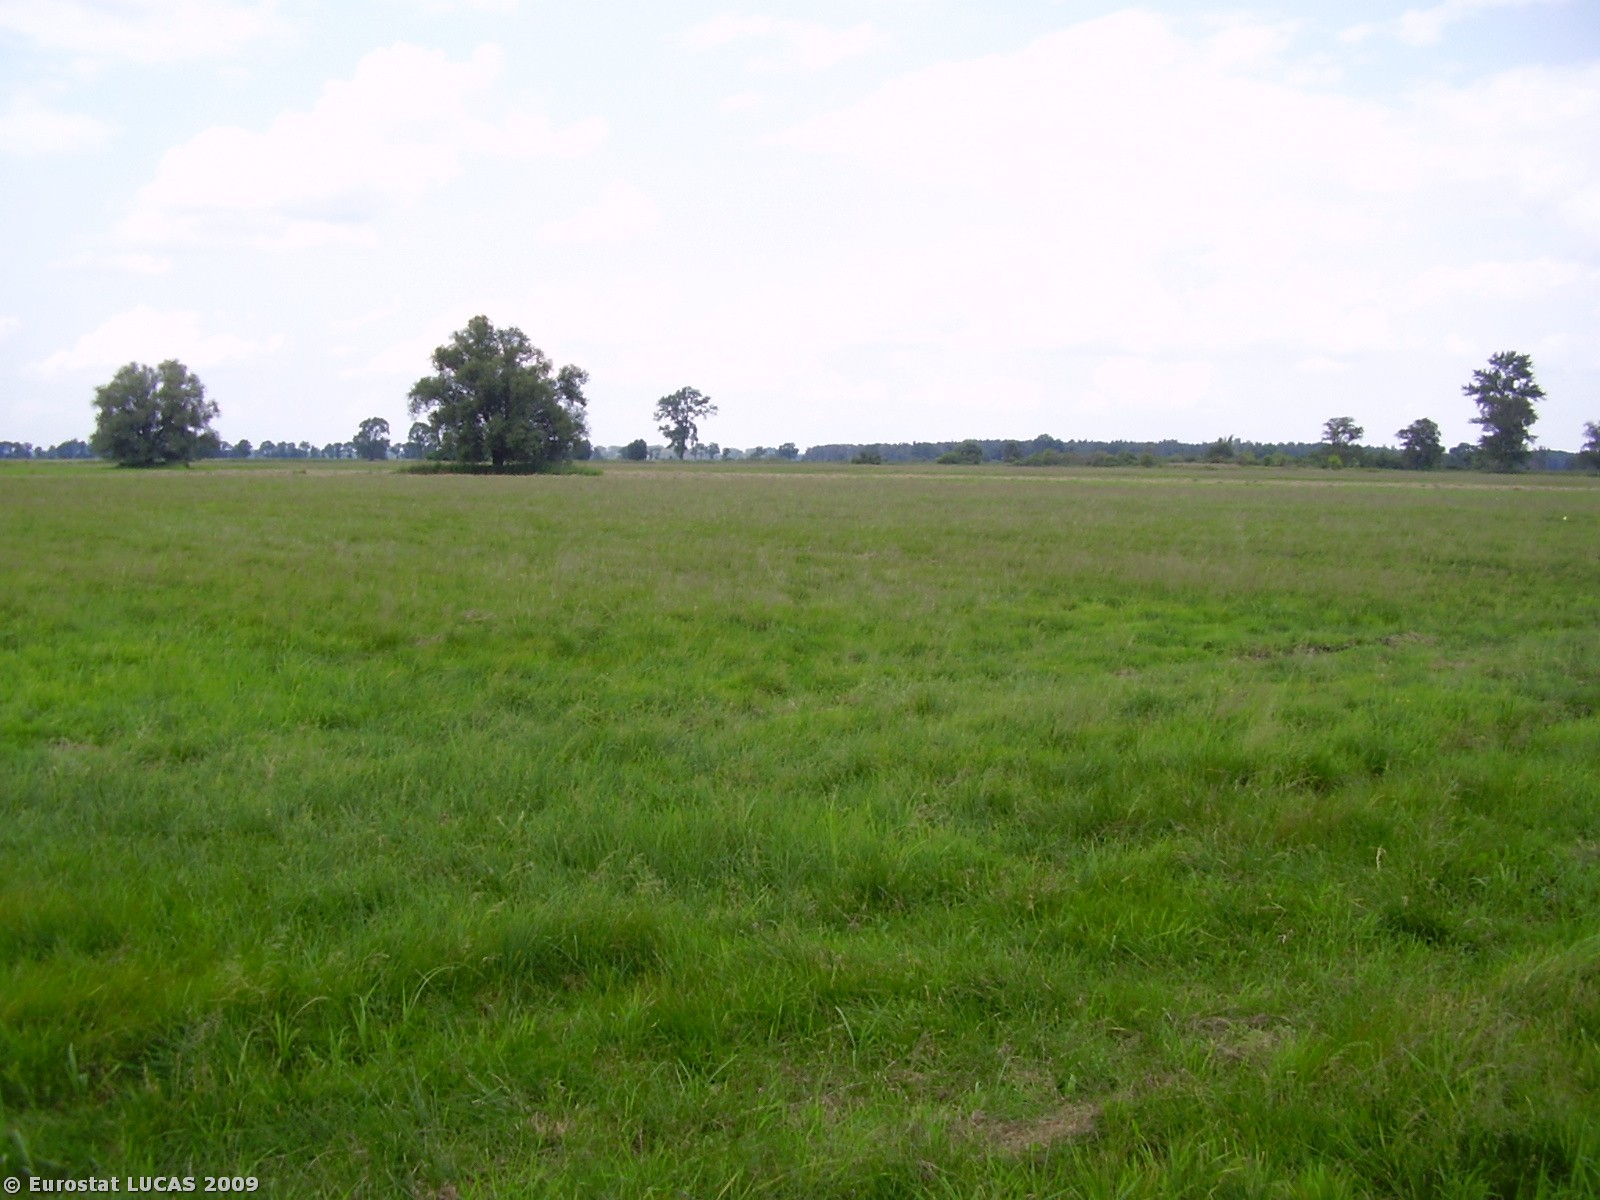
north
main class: Grassland
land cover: Grassland without tree/shrub cover
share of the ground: > 75 %
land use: Agriculture (excluding fallow land and kitchen gardens)
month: July
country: PL
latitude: 52.0304
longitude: 16.2889
